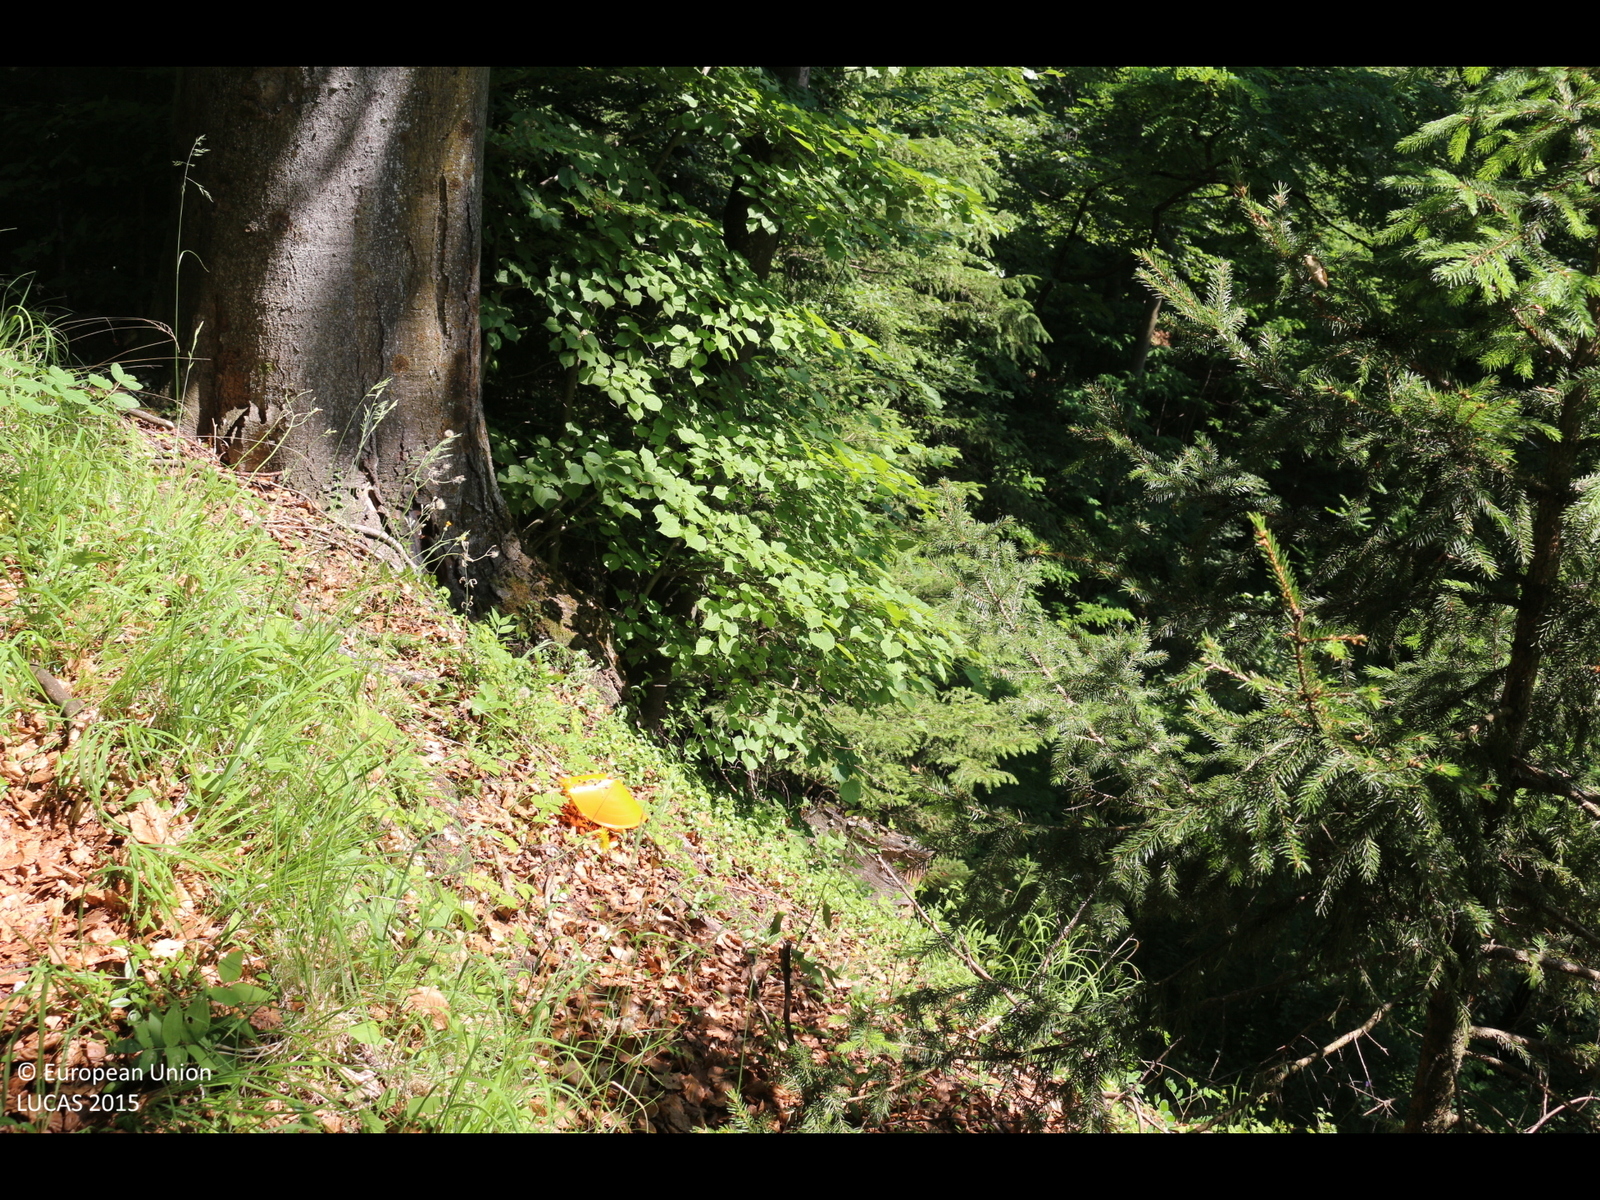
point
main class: Woodland
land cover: Broadleaved woodland
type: mountainous beech forest
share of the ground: > 75 %
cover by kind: broadleaved forest trees 95 %, coniferous forest trees 5 %
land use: Forestry
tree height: > 5 m
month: June
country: AT
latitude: 46.6217
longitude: 13.9281
